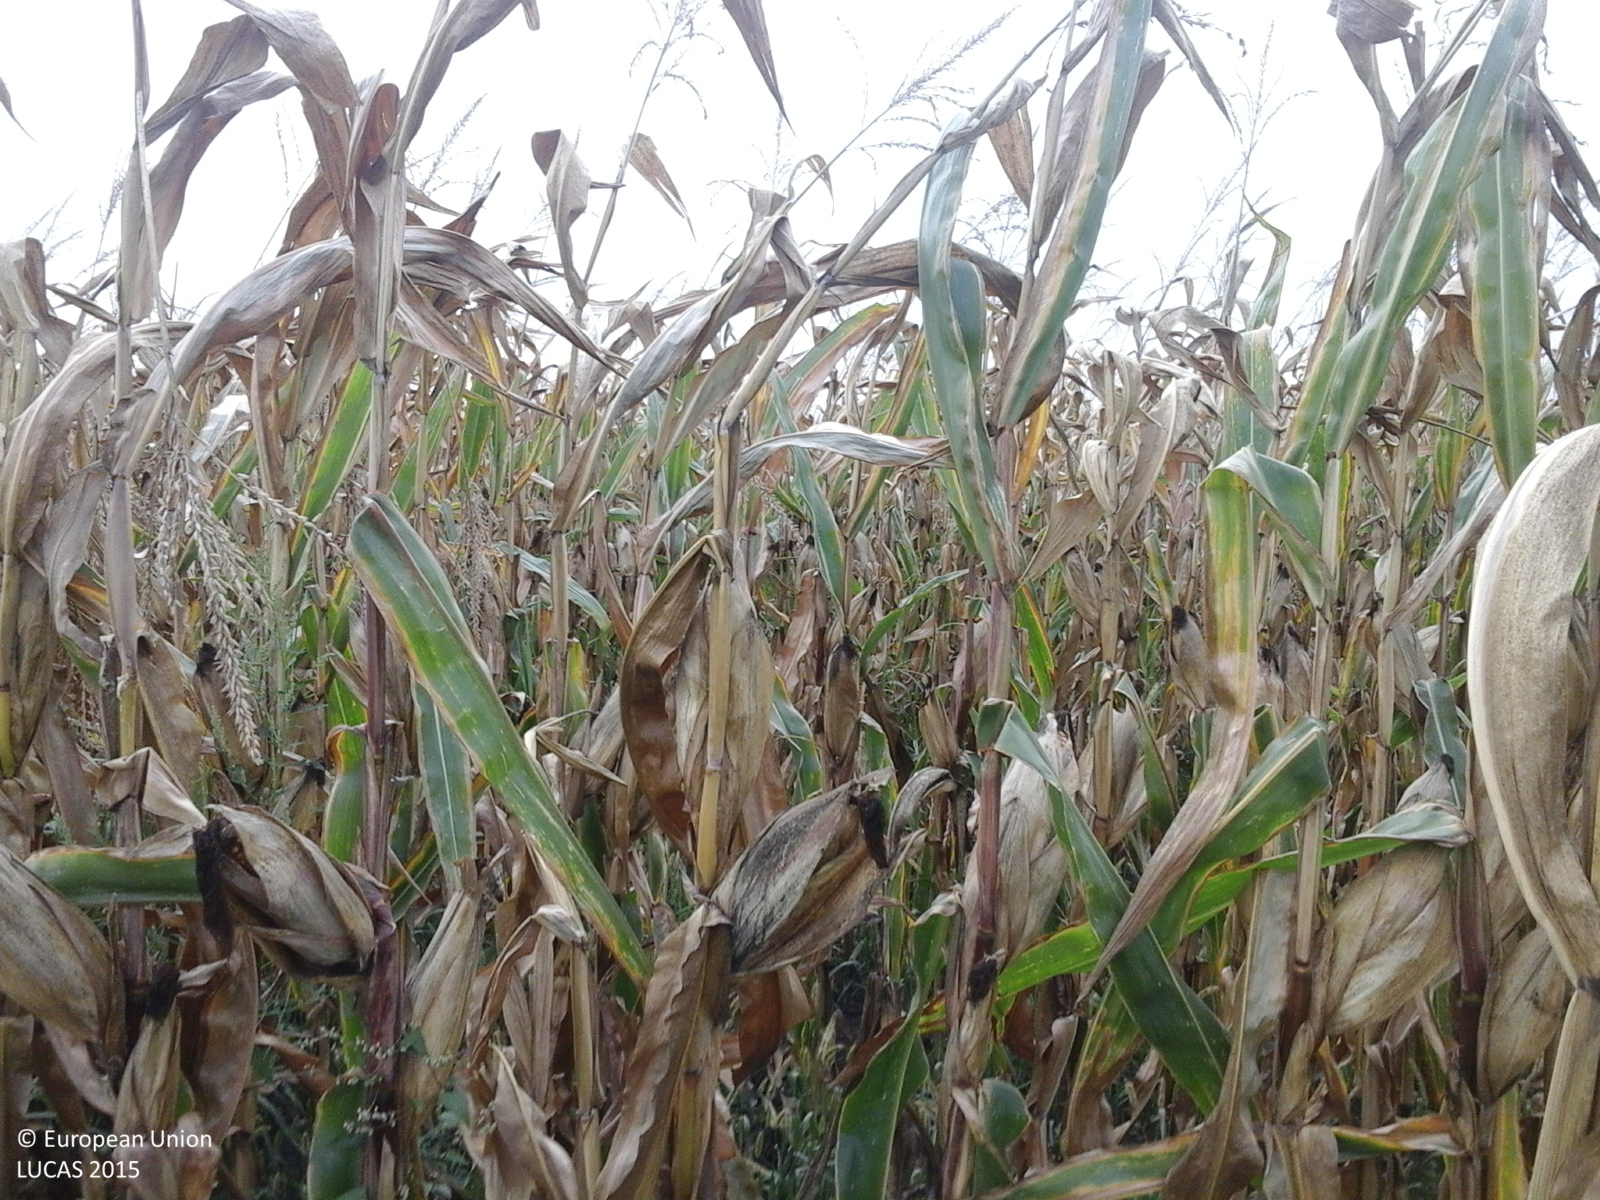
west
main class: Cropland
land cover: Maize
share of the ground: > 75 %
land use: Agriculture (excluding fallow land and kitchen gardens)
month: August
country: RO
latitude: 46.3734
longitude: 21.2533
